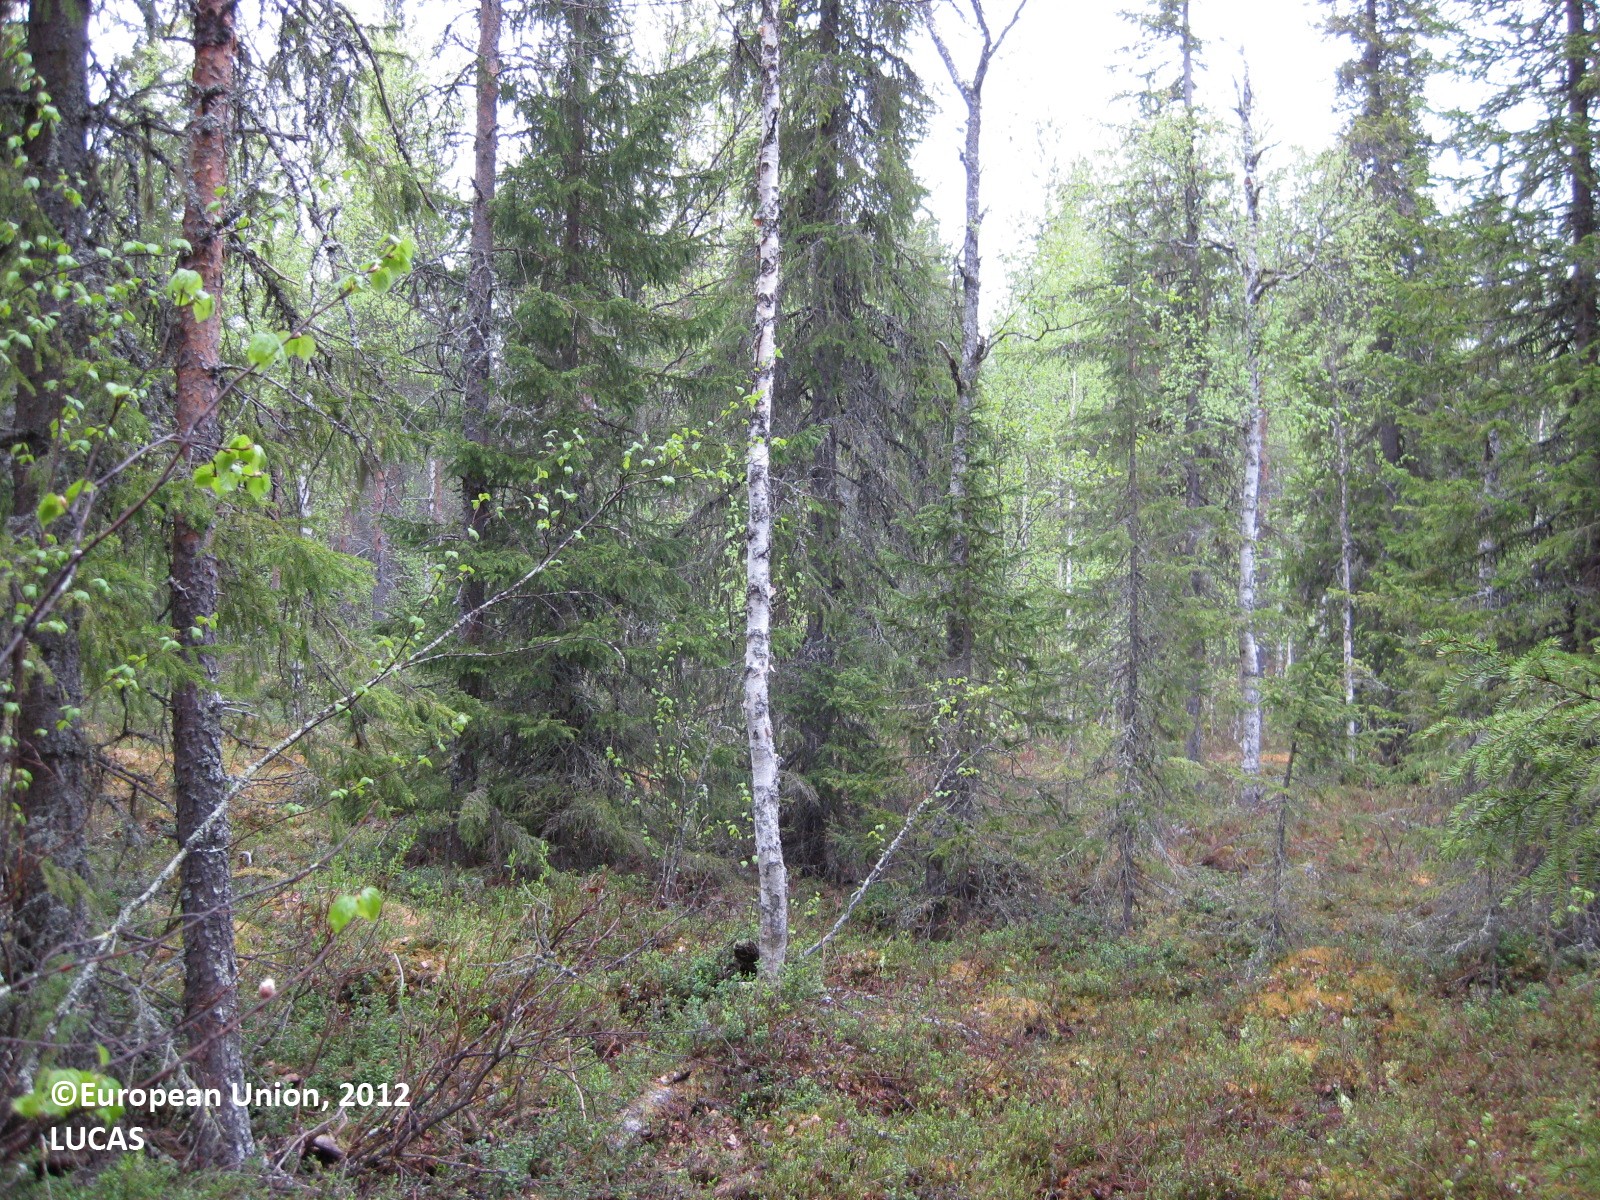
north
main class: Woodland
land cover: Spruce dominated mixed woodland
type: boreal forest
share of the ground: > 75 %
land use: Forestry
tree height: > 5 m
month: June
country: FI
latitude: 65.3277
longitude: 29.3239
